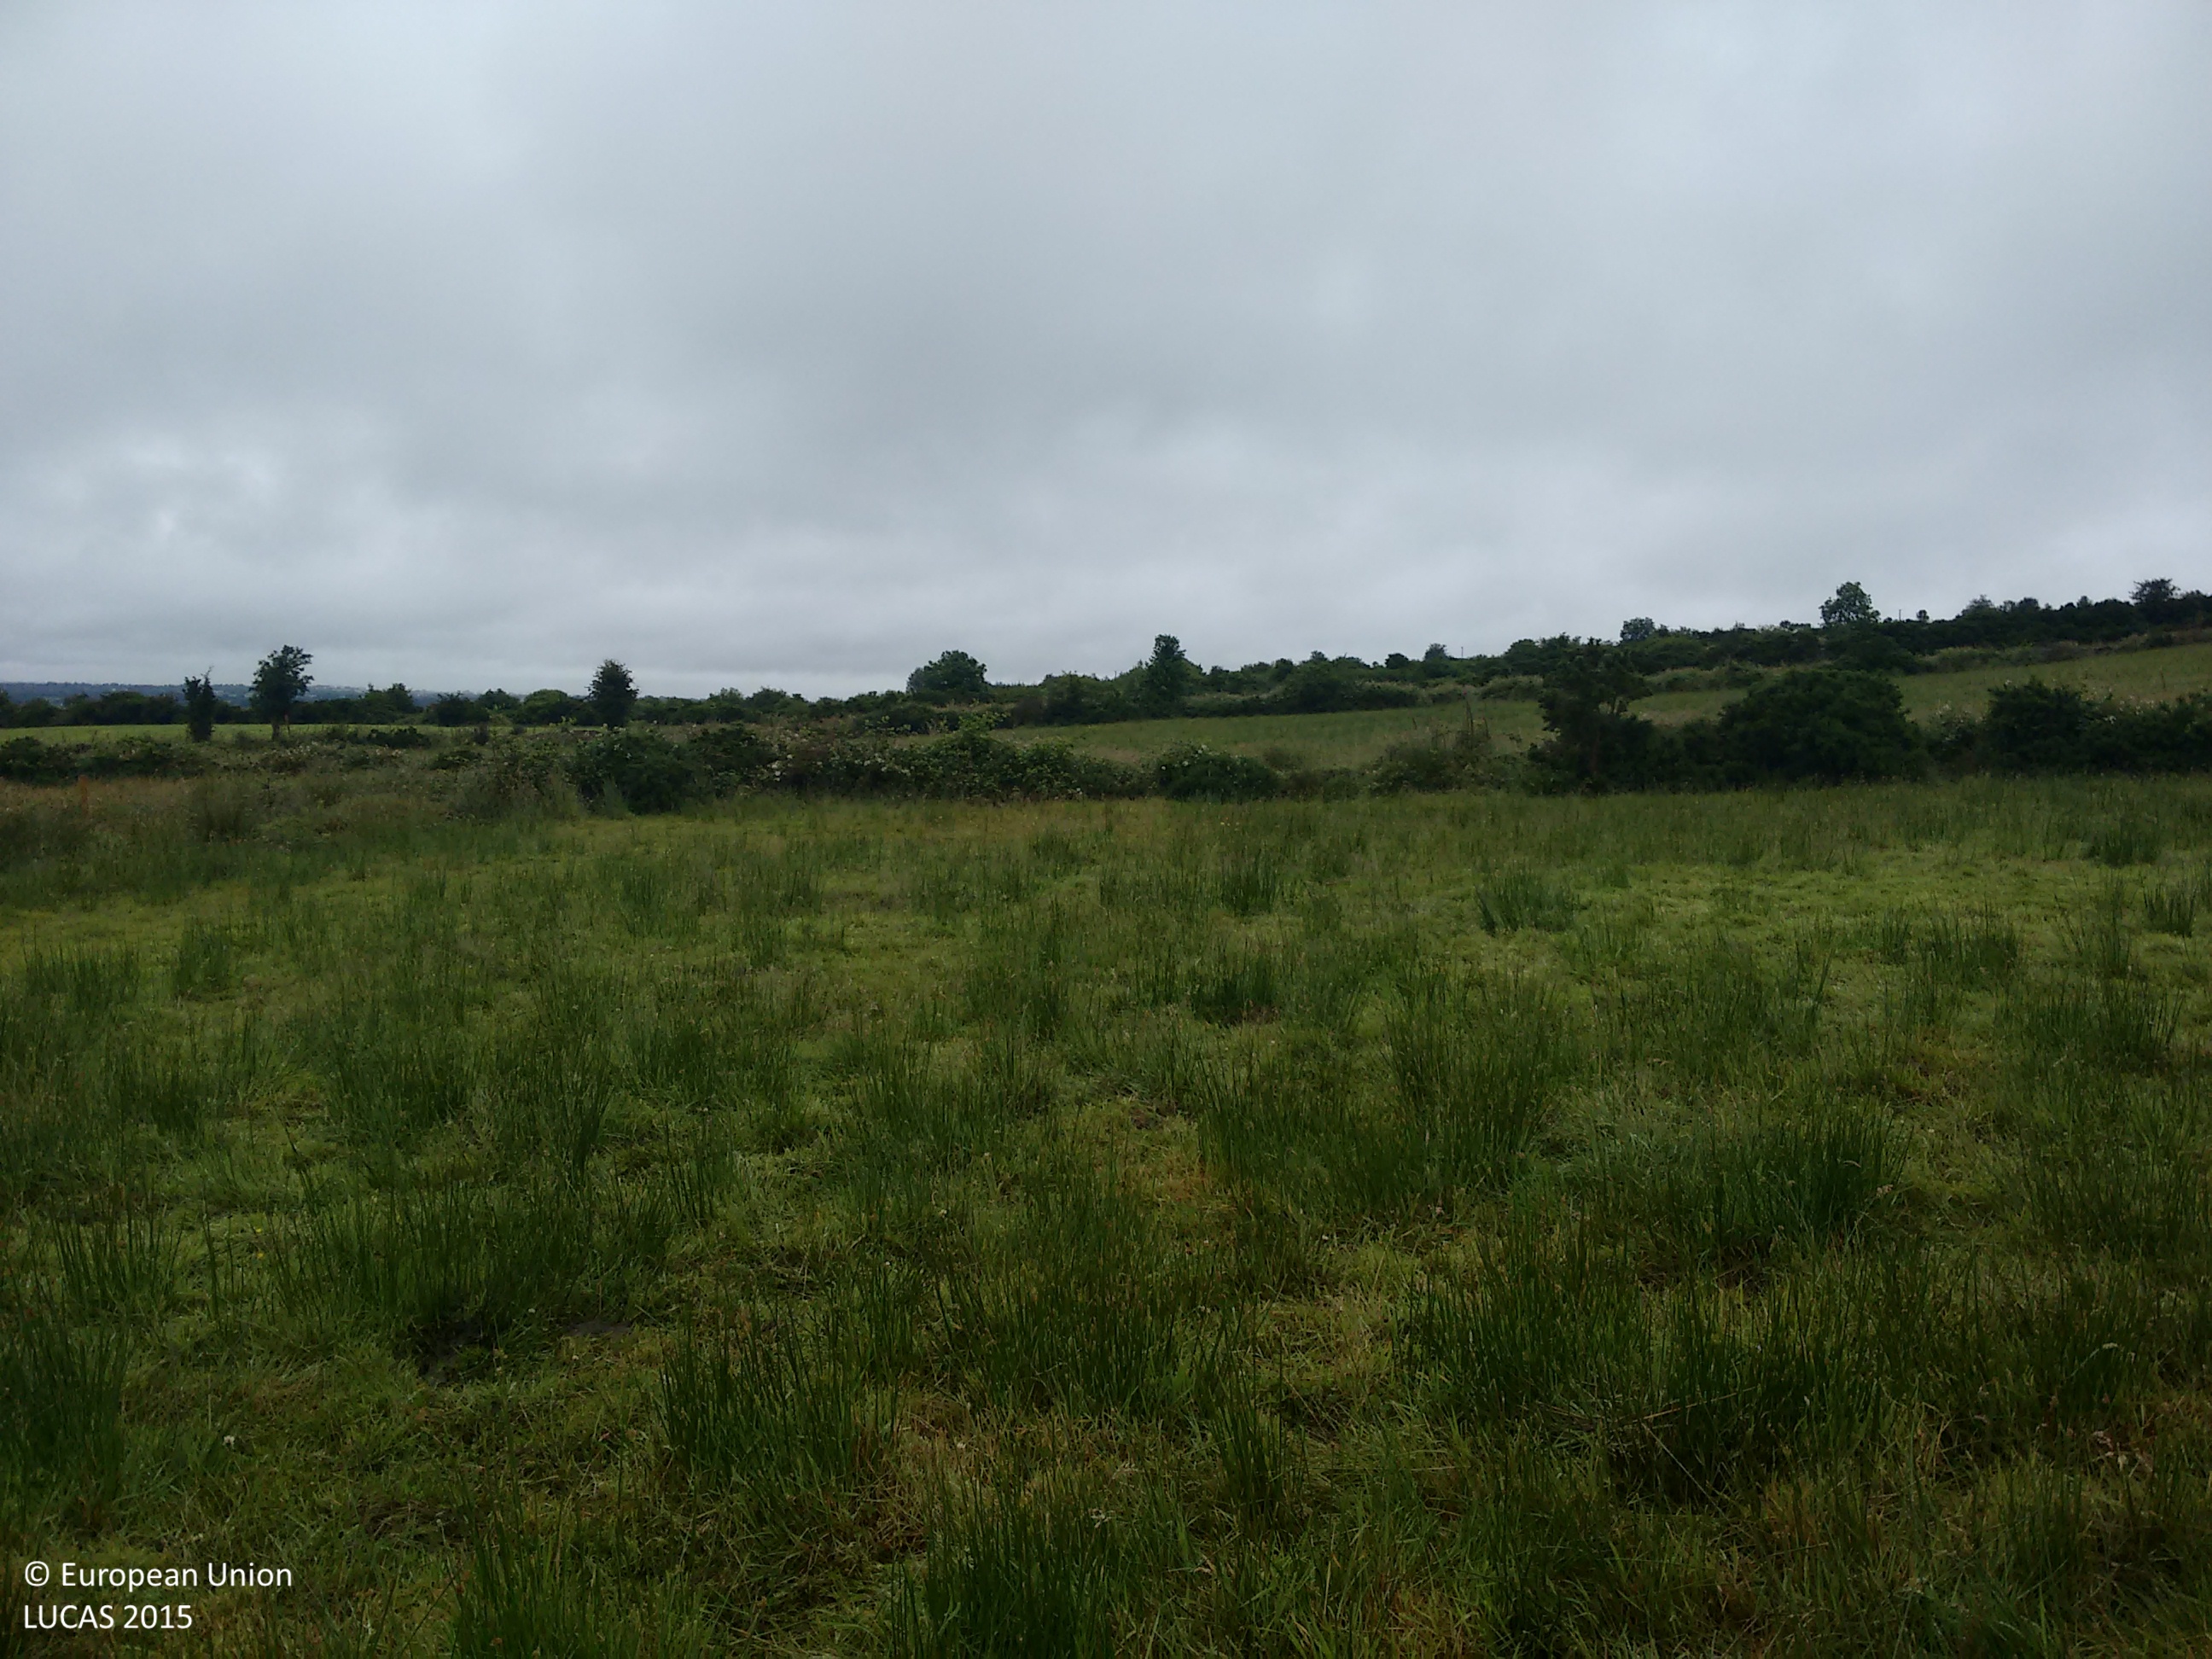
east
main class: Grassland
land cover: Grassland without tree/shrub cover
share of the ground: > 75 %
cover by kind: herbaceous plants 100 %
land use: Agriculture (excluding fallow land and kitchen gardens)
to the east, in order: Grassland without tree/shrub cover; Managed hedges; Ditches and canals; Grassland without tree/shrub cover; Managed hedges; Ditches and canals; Grassland without tree/shrub cover; Managed hedges; Grassland without tree/shrub cover; Electric lines; Ditches and canals; Shrubland with sparse tree cover; Inland marshes
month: July
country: IE
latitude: 53.6630
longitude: -7.7358
